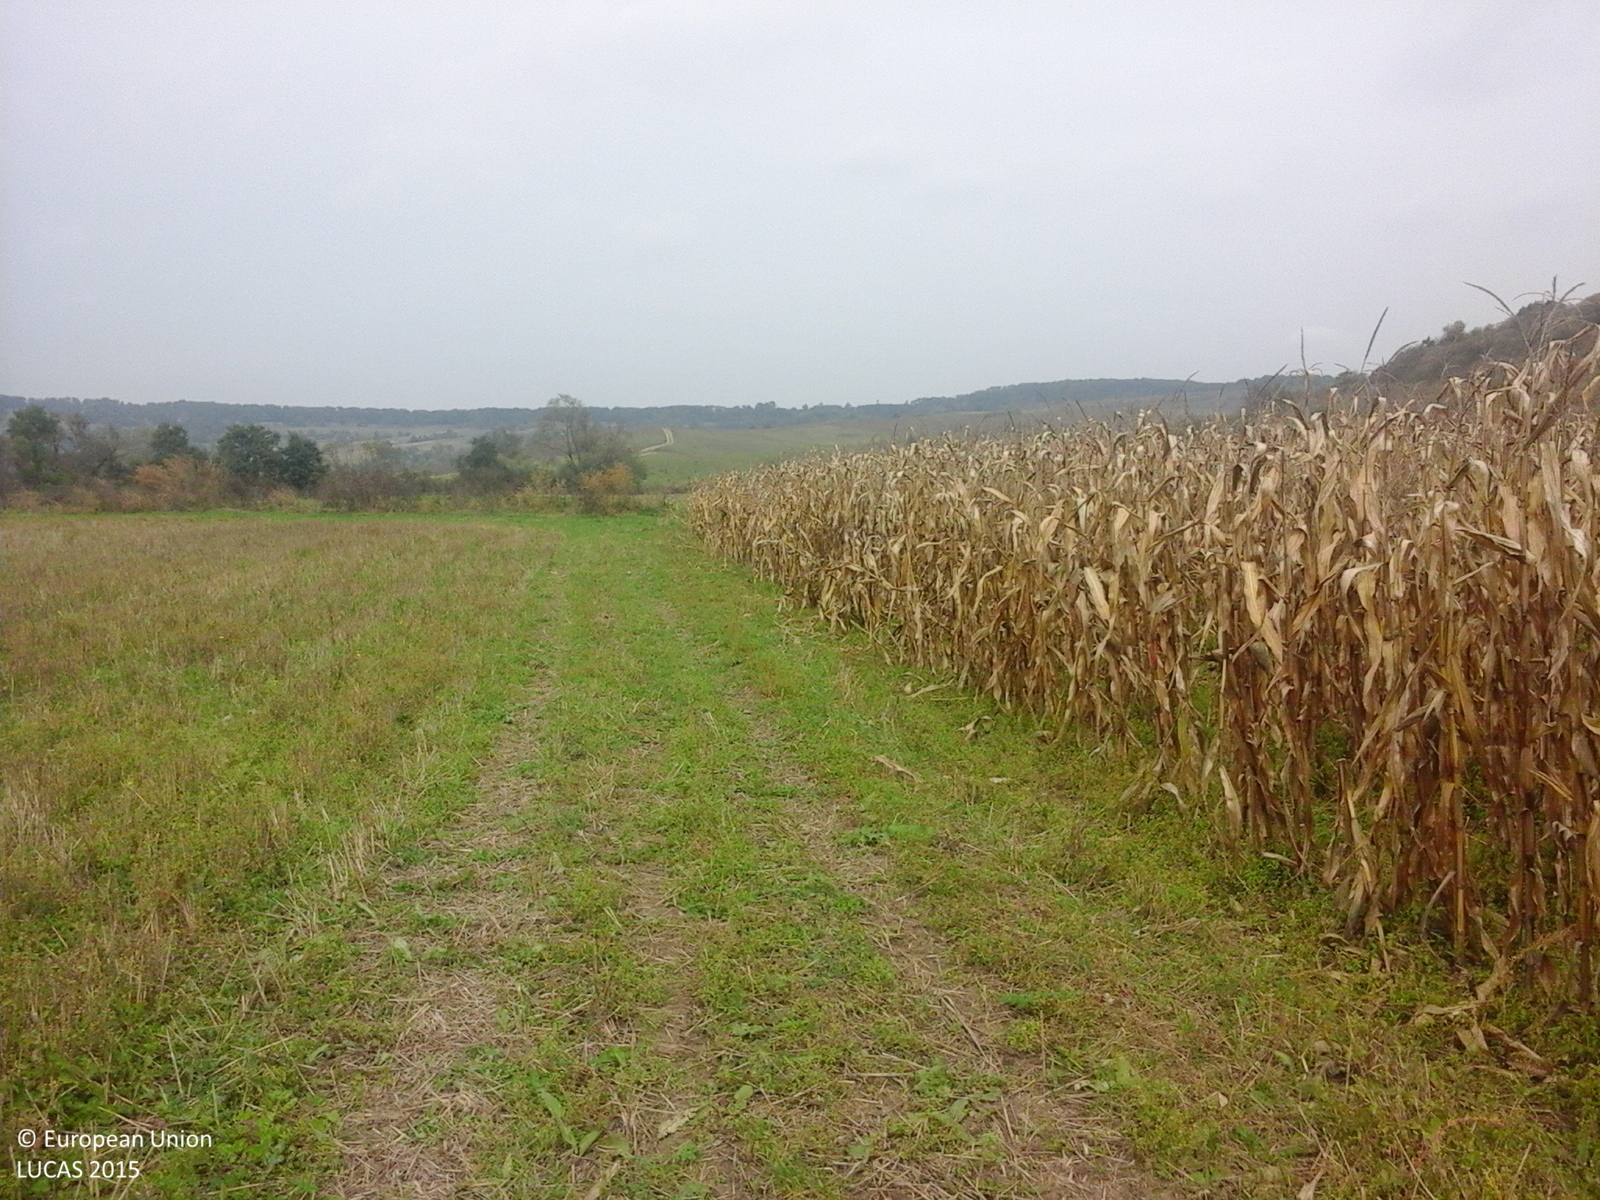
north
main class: Cropland
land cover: Common wheat
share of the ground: 25 - 50 %
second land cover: Spontaneously vegetated surfaces
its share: 50 - 75 %
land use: Agriculture (excluding fallow land and kitchen gardens)
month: October
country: RO
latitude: 45.9734
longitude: 25.1850
